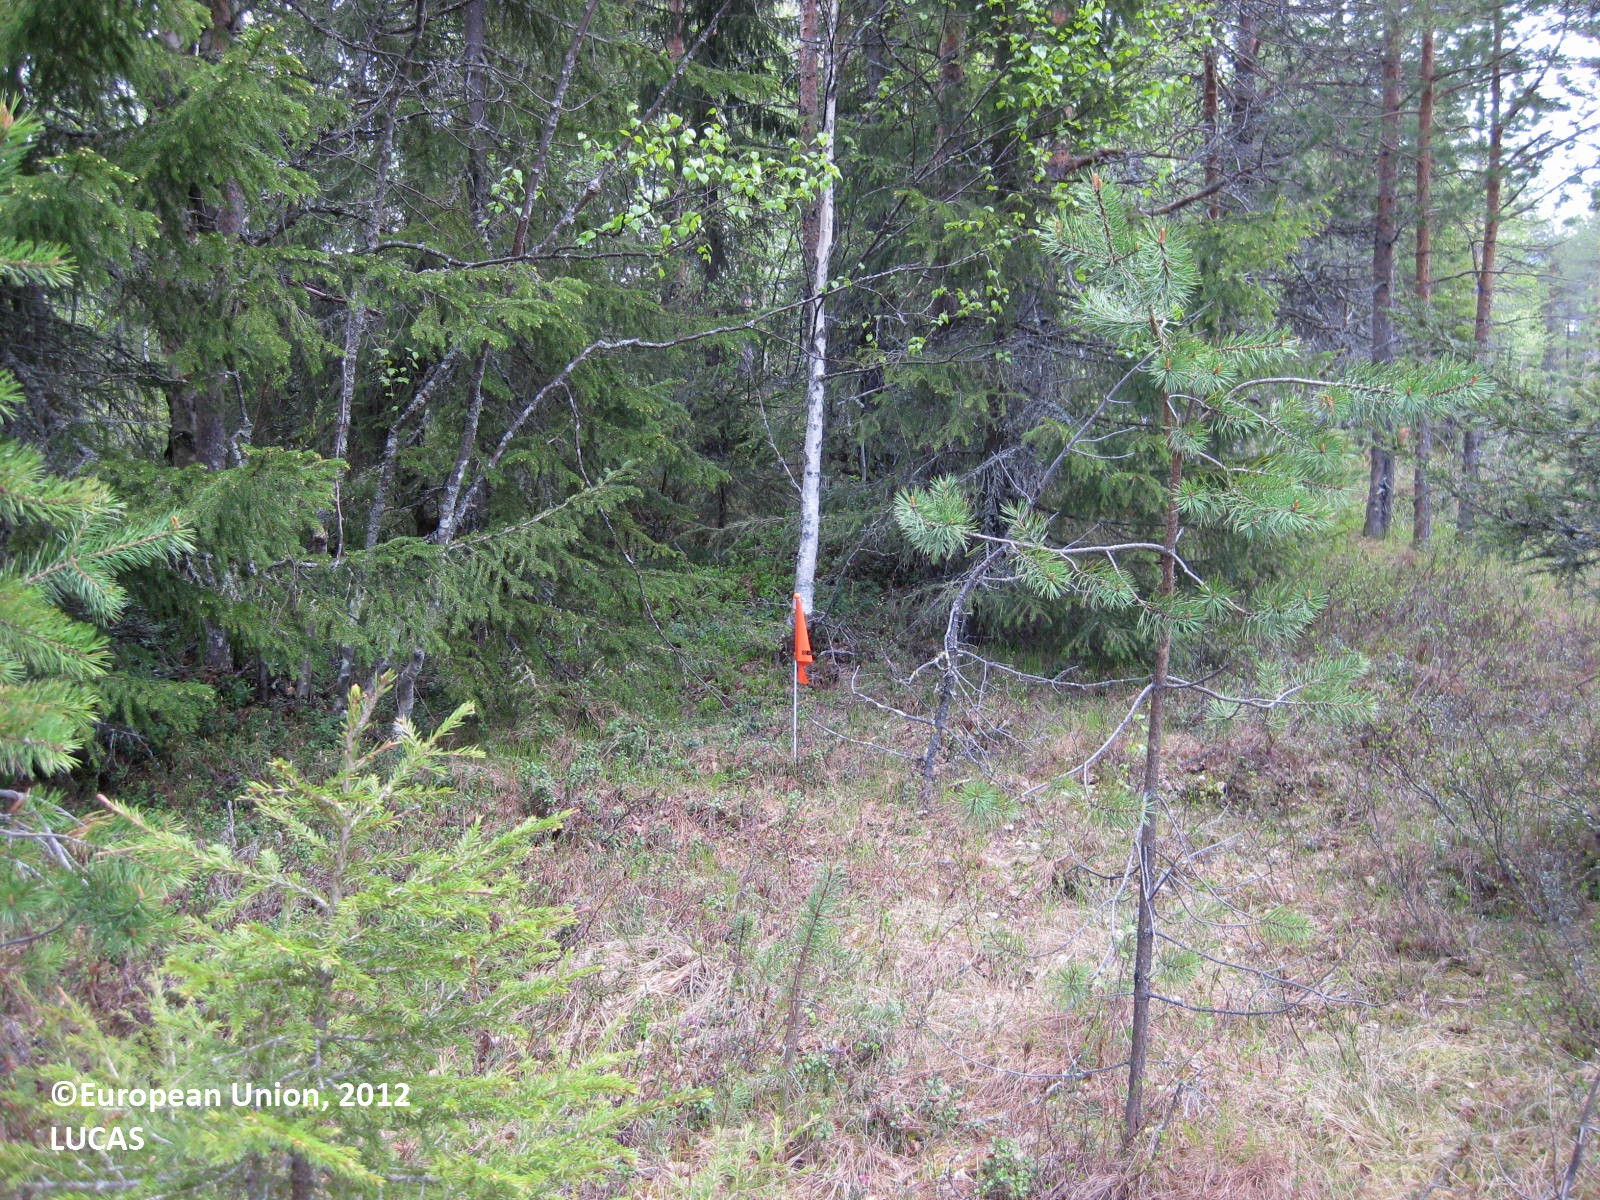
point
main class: Woodland
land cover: Spruce dominated mixed woodland
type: boreal forest
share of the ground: 50 - 75 %
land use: Forestry
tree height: > 5 m
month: June
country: FI
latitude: 65.0540
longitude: 29.5662
